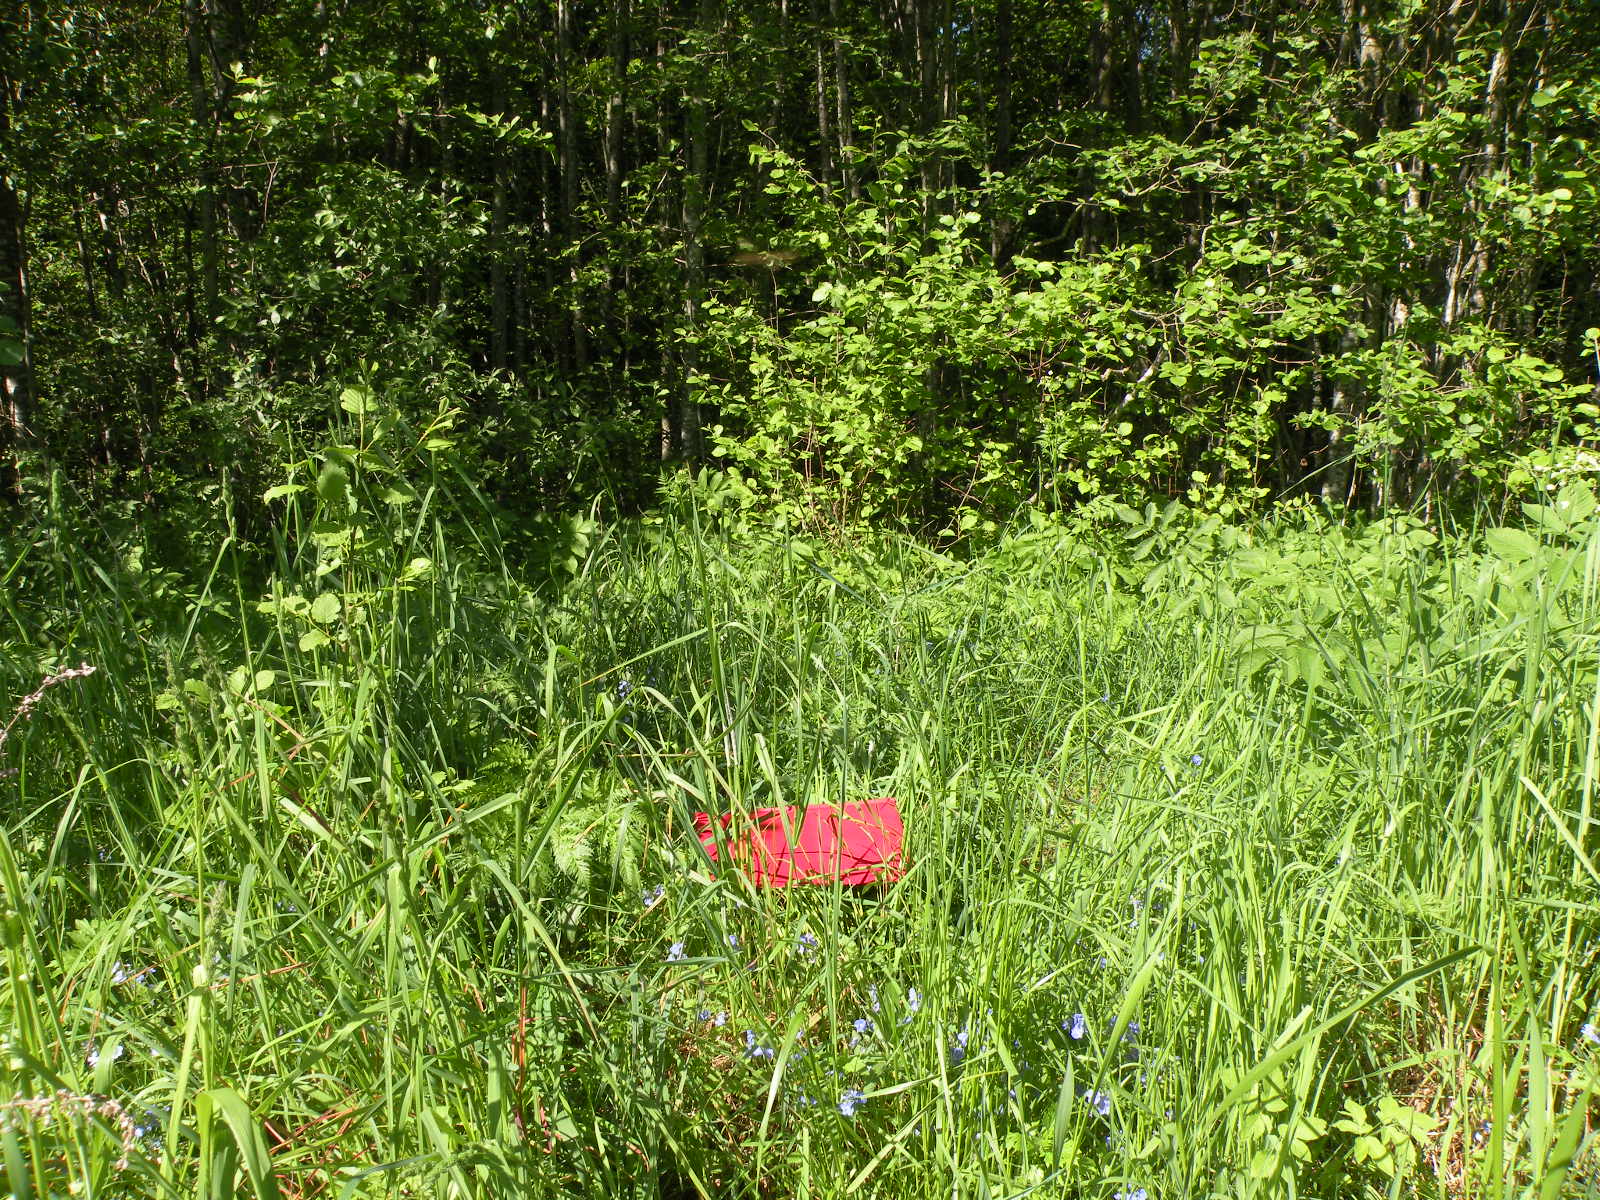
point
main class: Grassland
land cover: Grassland without tree/shrub cover
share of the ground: > 75 %
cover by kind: herbaceous plants 100 %
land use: Agriculture (excluding fallow land and kitchen gardens)
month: May
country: LV
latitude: 56.0259
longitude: 26.2360
